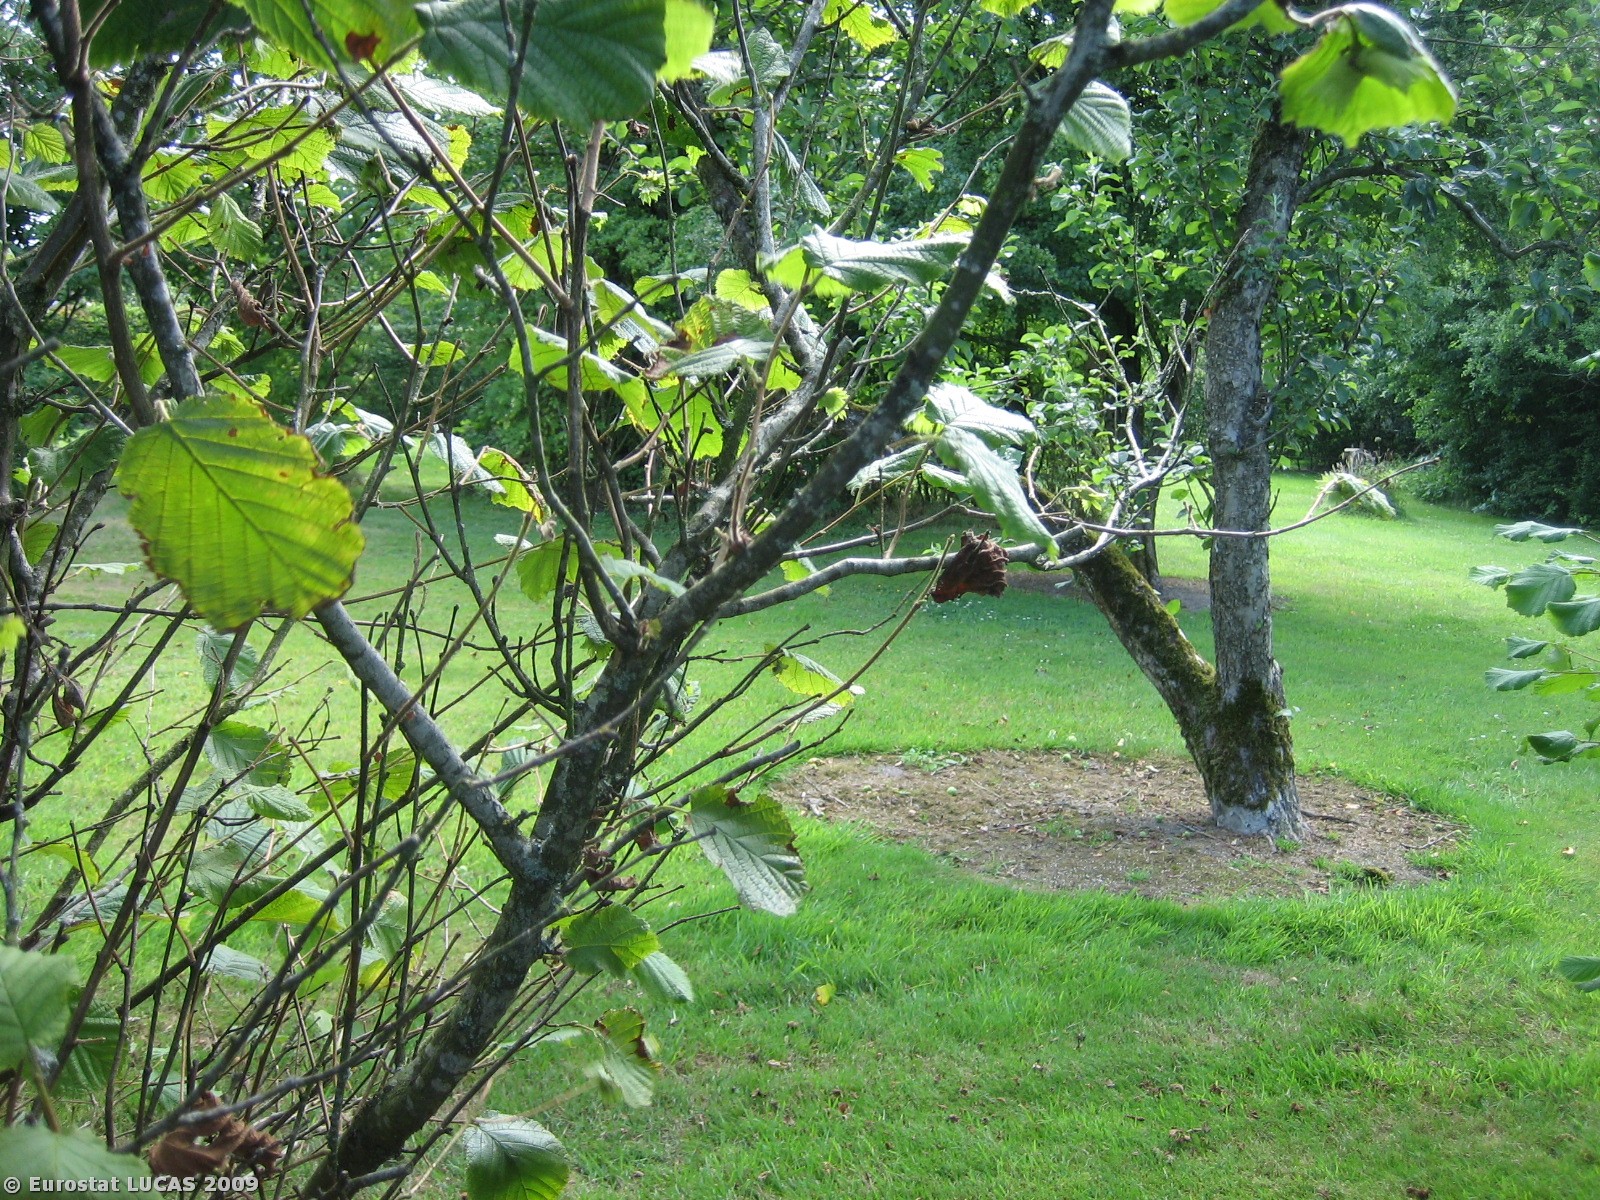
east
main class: Grassland
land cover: Grassland with sparse tree/shrub cover
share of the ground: > 75 %
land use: Residential
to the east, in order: Grassland with sparse tree/shrub cover; Fences; Grassland without tree/shrub cover; Single bushes/trees; Grassland without tree/shrub cover; Broadleaved woodland; Grassland without tree/shrub cover; Tracks; Grassland without tree/shrub cover; Tracks; Paved roads, cycling and walking lanes; Tracks; Broadleaved woodland; Rivers and streams; Broadleaved woodland; Grassland without tree/shrub cover; Tracks; Broadleaved woodland; Grassland without tree/shrub cover
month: July
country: DK
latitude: 55.6971
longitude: 8.8397
